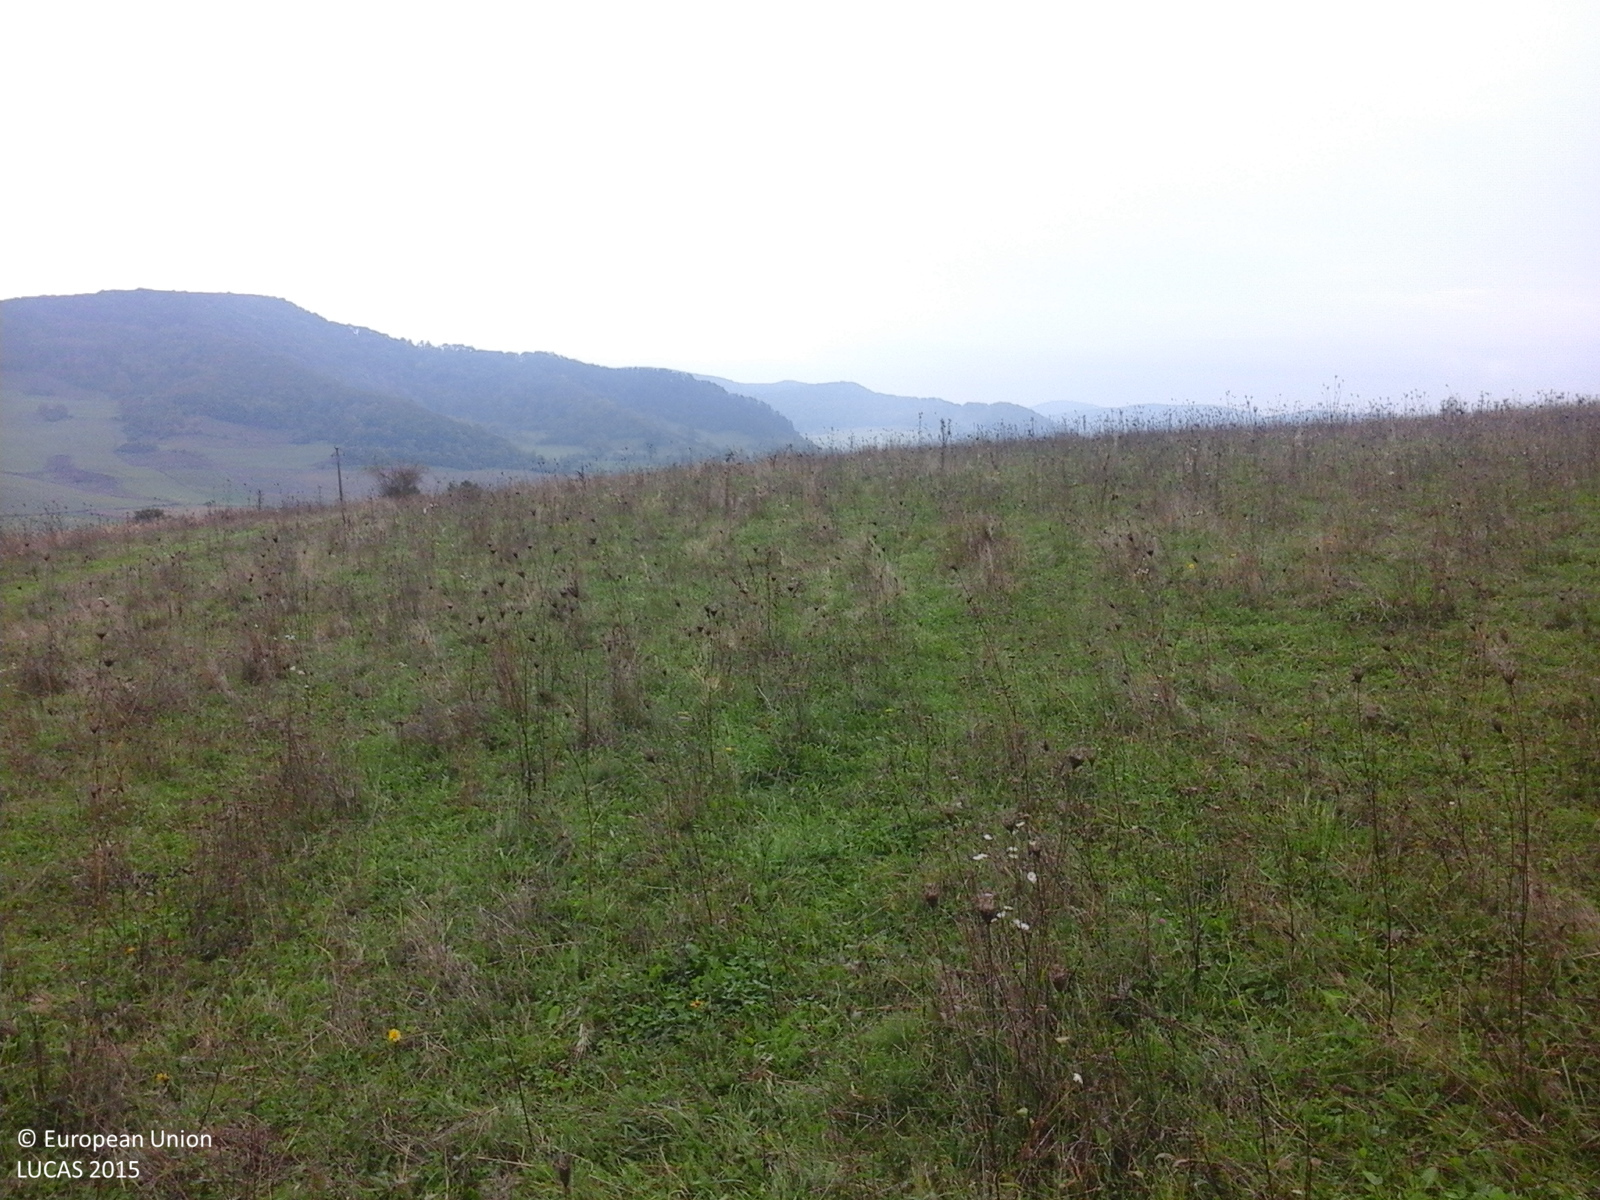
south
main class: Grassland
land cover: Grassland without tree/shrub cover
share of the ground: > 75 %
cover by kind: herbaceous plants 100 %
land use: Agriculture (excluding fallow land and kitchen gardens)
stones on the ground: < 10 %
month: October
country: RO
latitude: 46.3695
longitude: 24.7144
